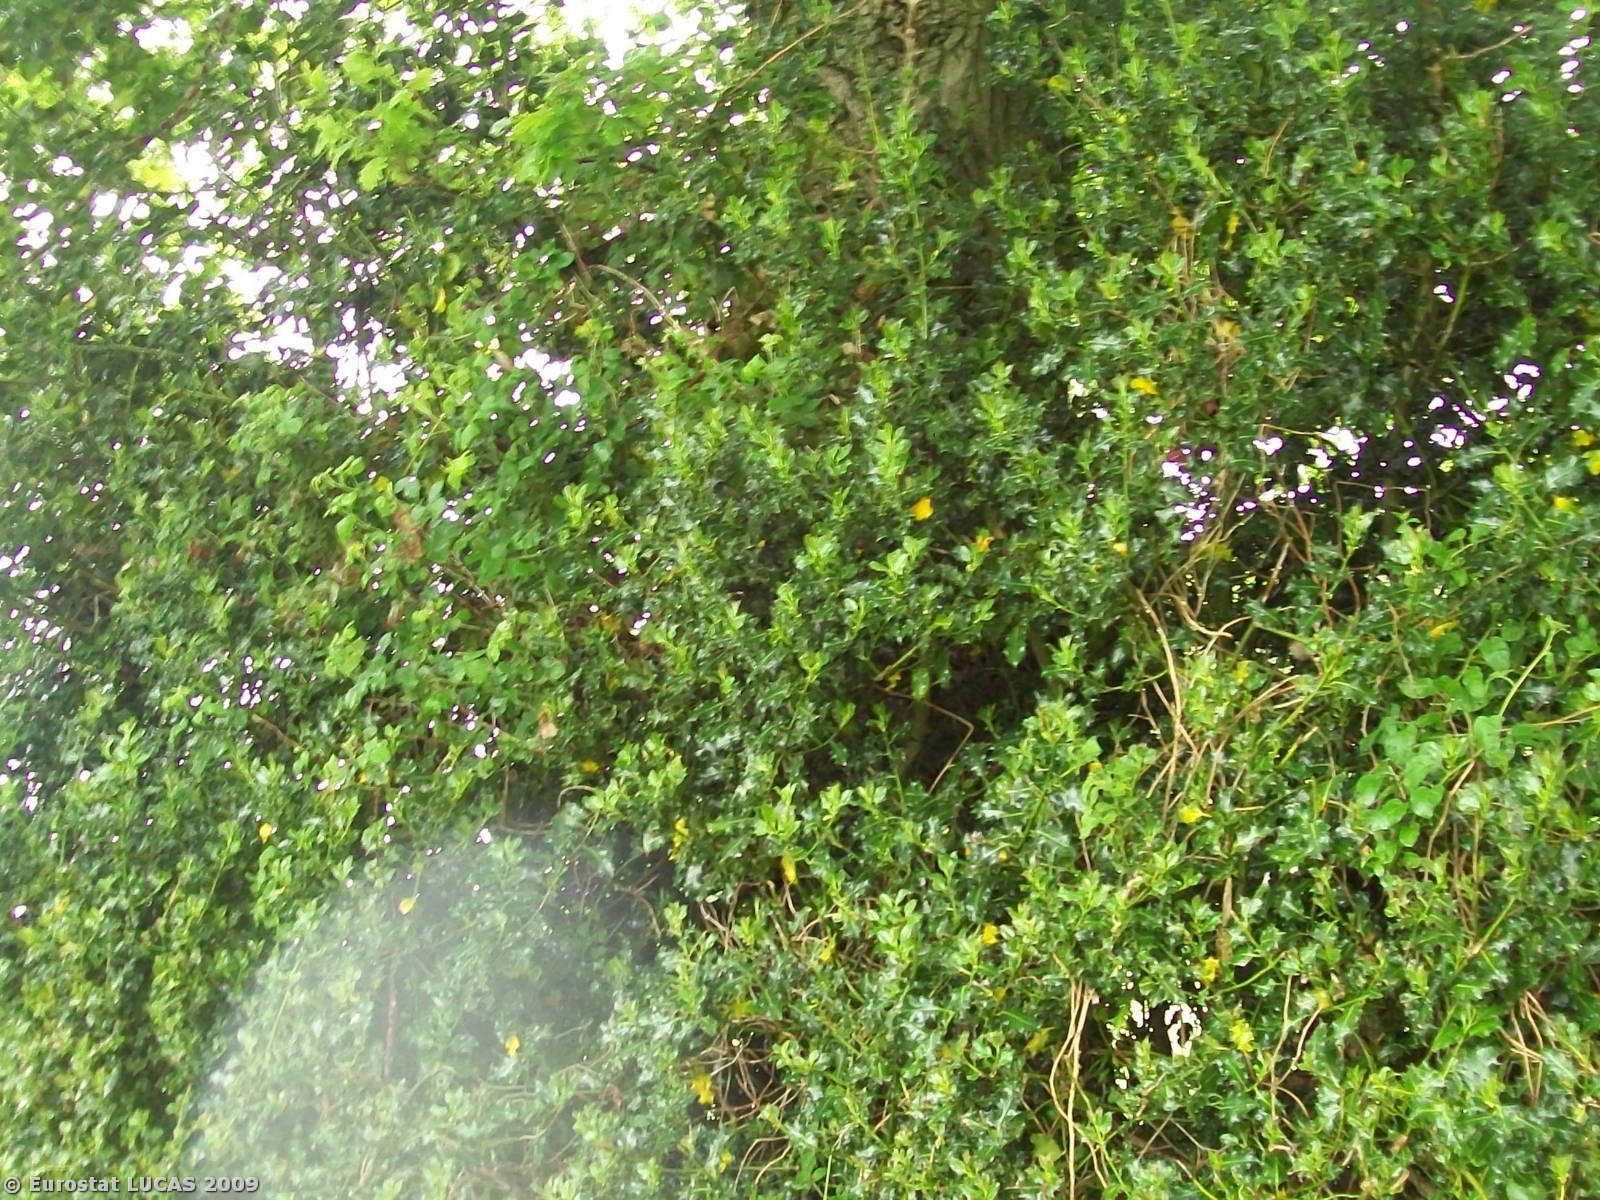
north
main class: Grassland
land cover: Grassland without tree/shrub cover
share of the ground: > 75 %
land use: Agriculture (excluding fallow land and kitchen gardens)
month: May
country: GB
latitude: 50.7636
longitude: -3.3369
